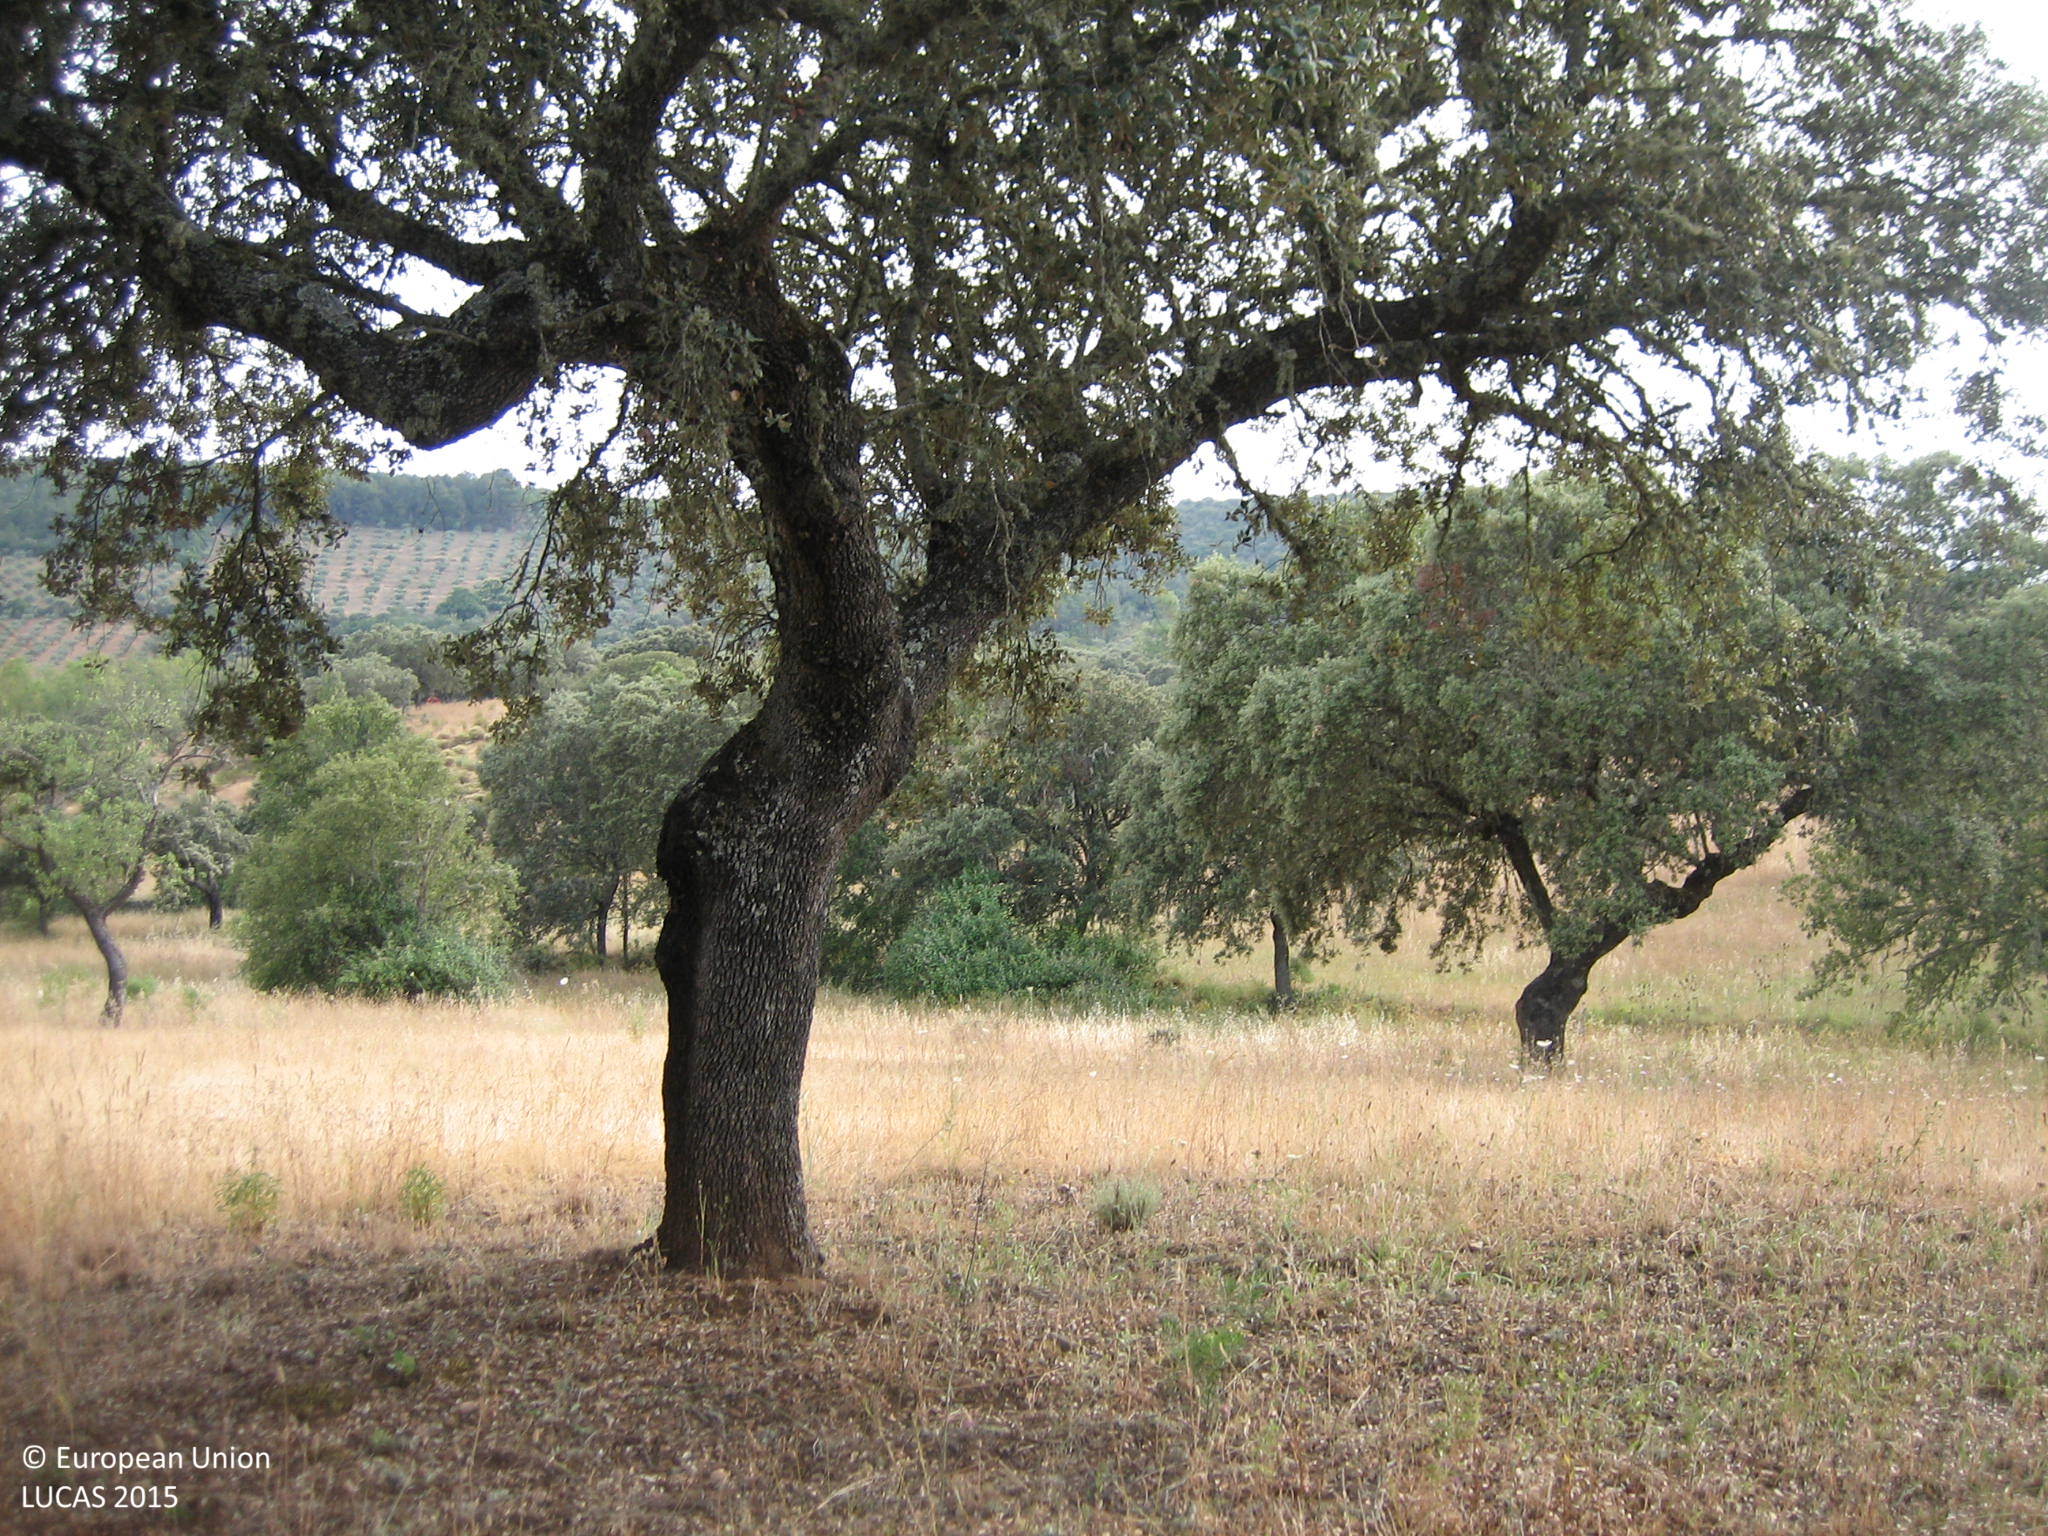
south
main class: Woodland
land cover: Broadleaved woodland
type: broadleaved evergreen forest
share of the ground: 10 - 25 %
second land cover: Spontaneously vegetated surfaces
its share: > 75 %
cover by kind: herbaceous plants 80 %, broadleaved forest trees 20 %
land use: Forestry
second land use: Agriculture (excluding fallow land and kitchen gardens)
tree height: > 5 m
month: June
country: ES
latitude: 39.3069
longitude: -4.8945
